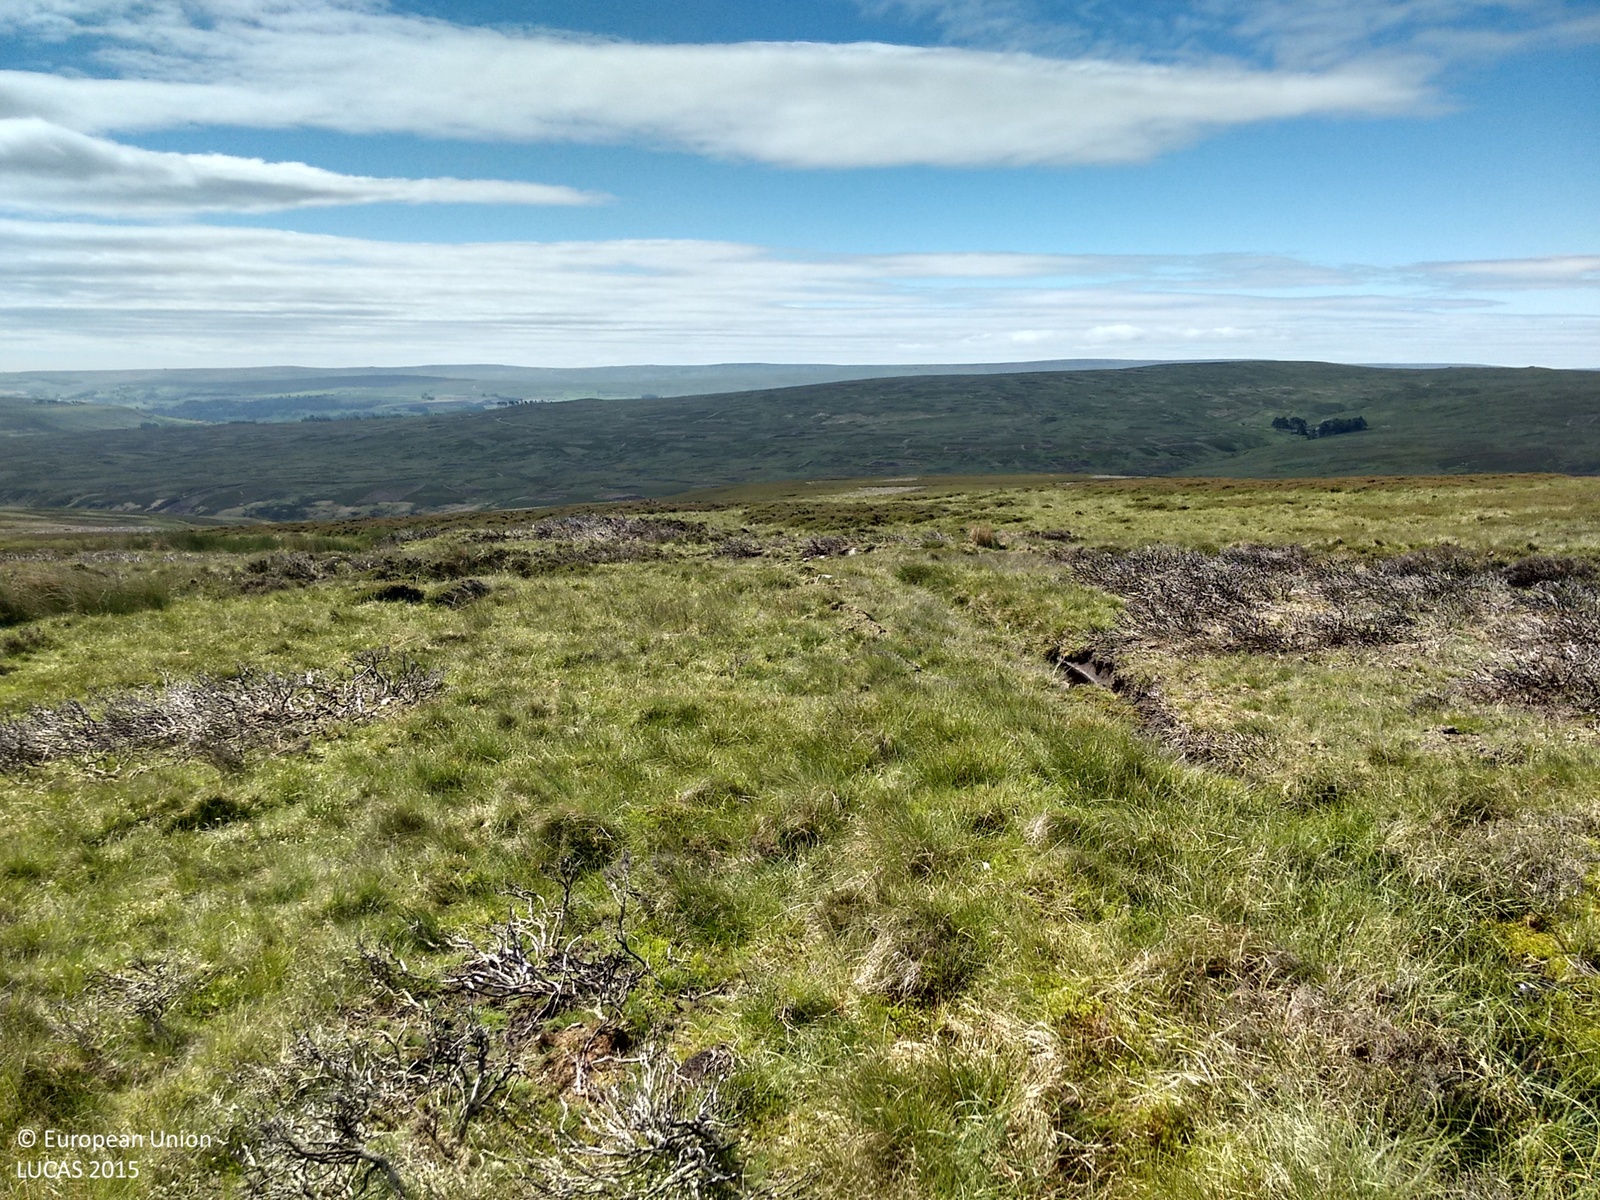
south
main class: Grassland
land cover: Grassland without tree/shrub cover
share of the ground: > 75 %
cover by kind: herbaceous plants 100 %
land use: Agriculture (excluding fallow land and kitchen gardens)
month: June
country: GB
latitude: 54.7986
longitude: -2.0488
